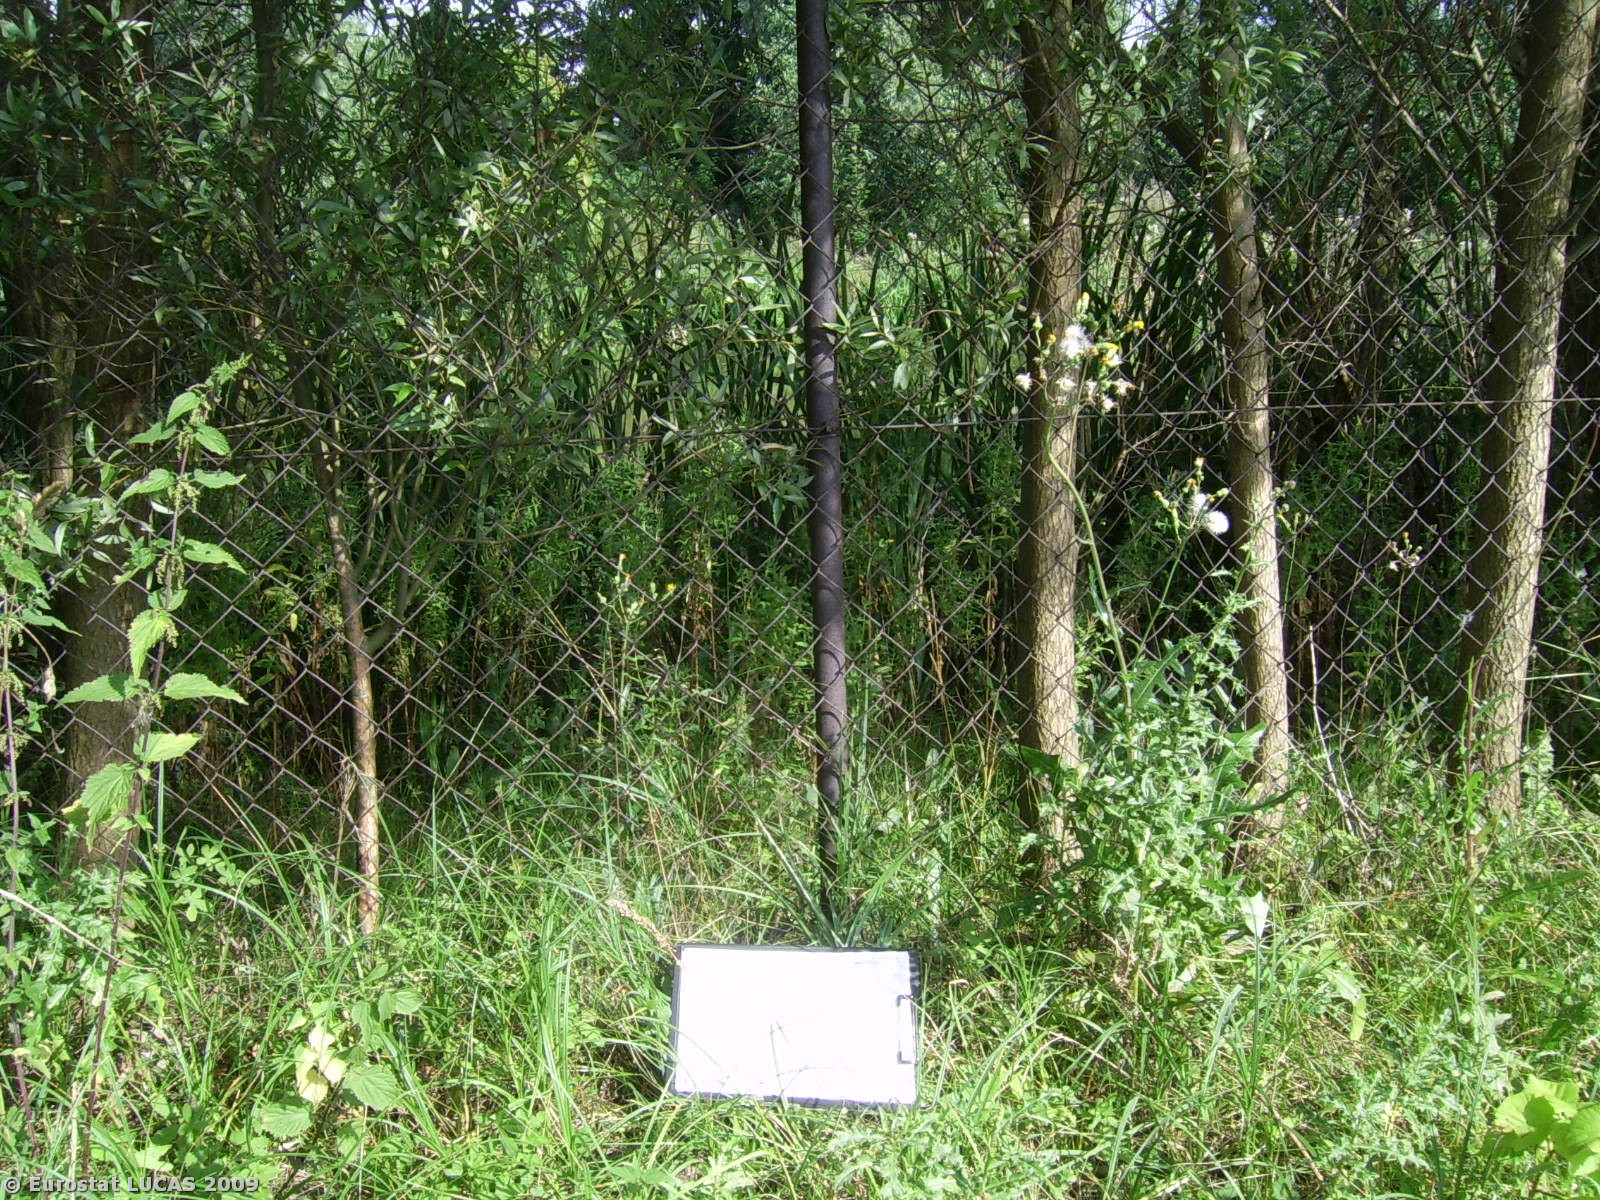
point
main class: Woodland
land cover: Broadleaved woodland
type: mesophytic deciduous forest
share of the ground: > 75 %
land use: Unused
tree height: > 5 m
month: August
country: PL
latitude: 53.2092
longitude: 18.7800
